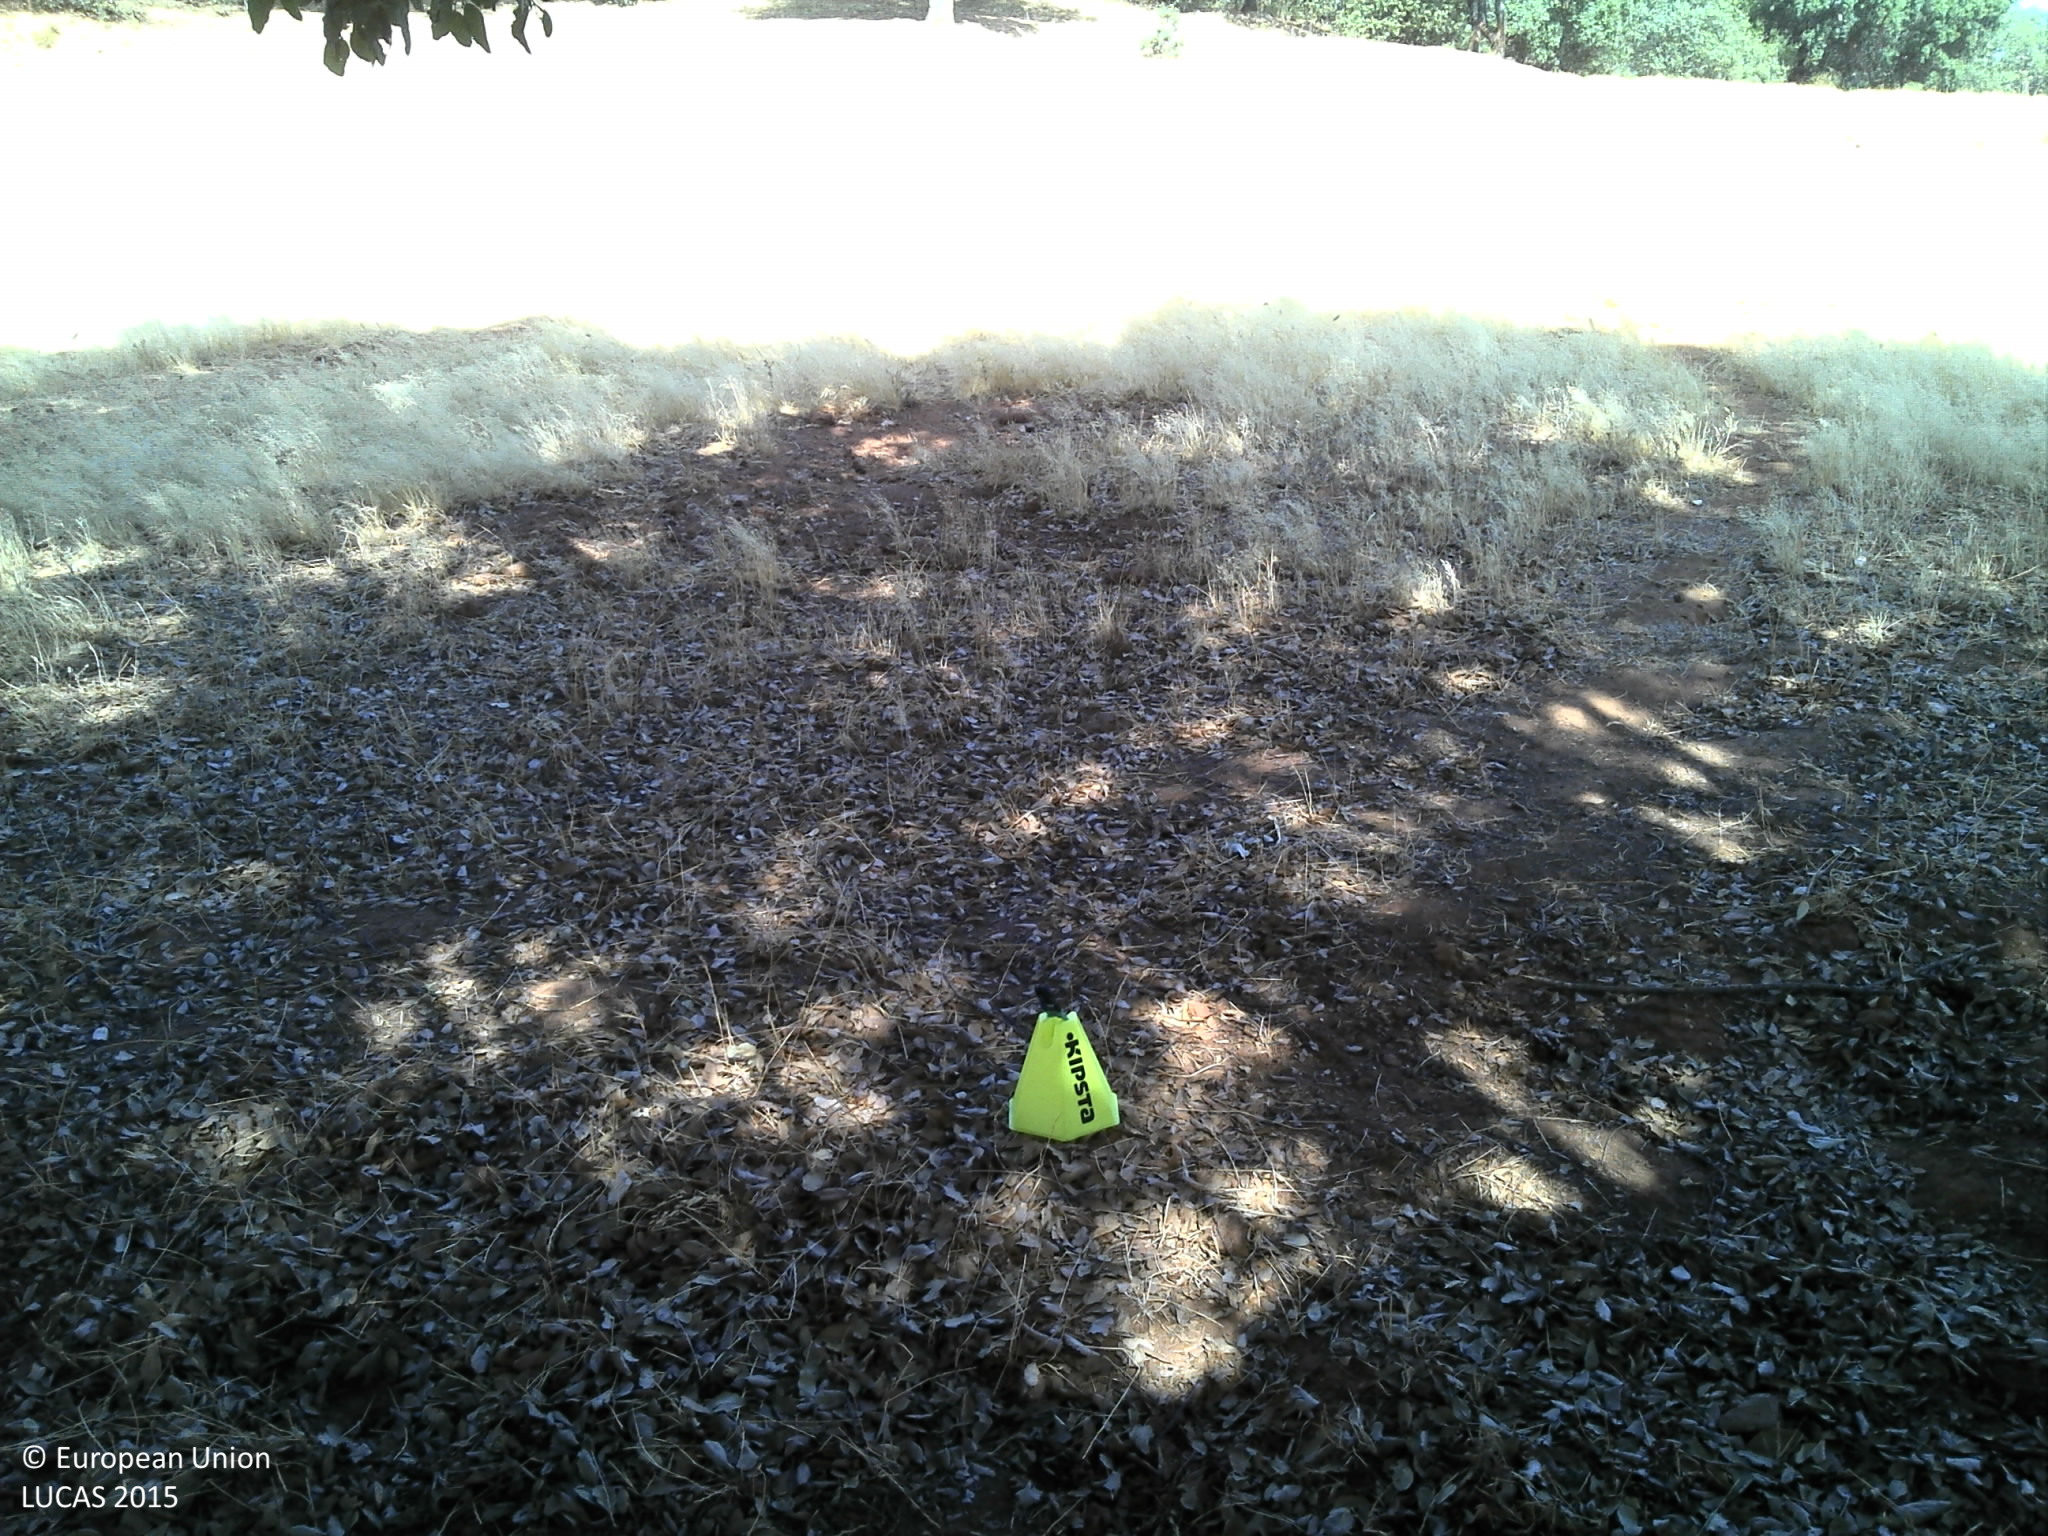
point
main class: Woodland
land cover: Broadleaved woodland
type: broadleaved evergreen forest
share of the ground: 10 - 25 %
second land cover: Spontaneously vegetated surfaces
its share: 10 - 25 %
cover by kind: unconsolidated bare surface 80 %, broadleaved forest trees 10 %, herbaceous plants 10 %
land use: Forestry
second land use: Agriculture (excluding fallow land and kitchen gardens)
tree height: > 5 m
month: July
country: PT
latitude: 38.3337
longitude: -7.7754
